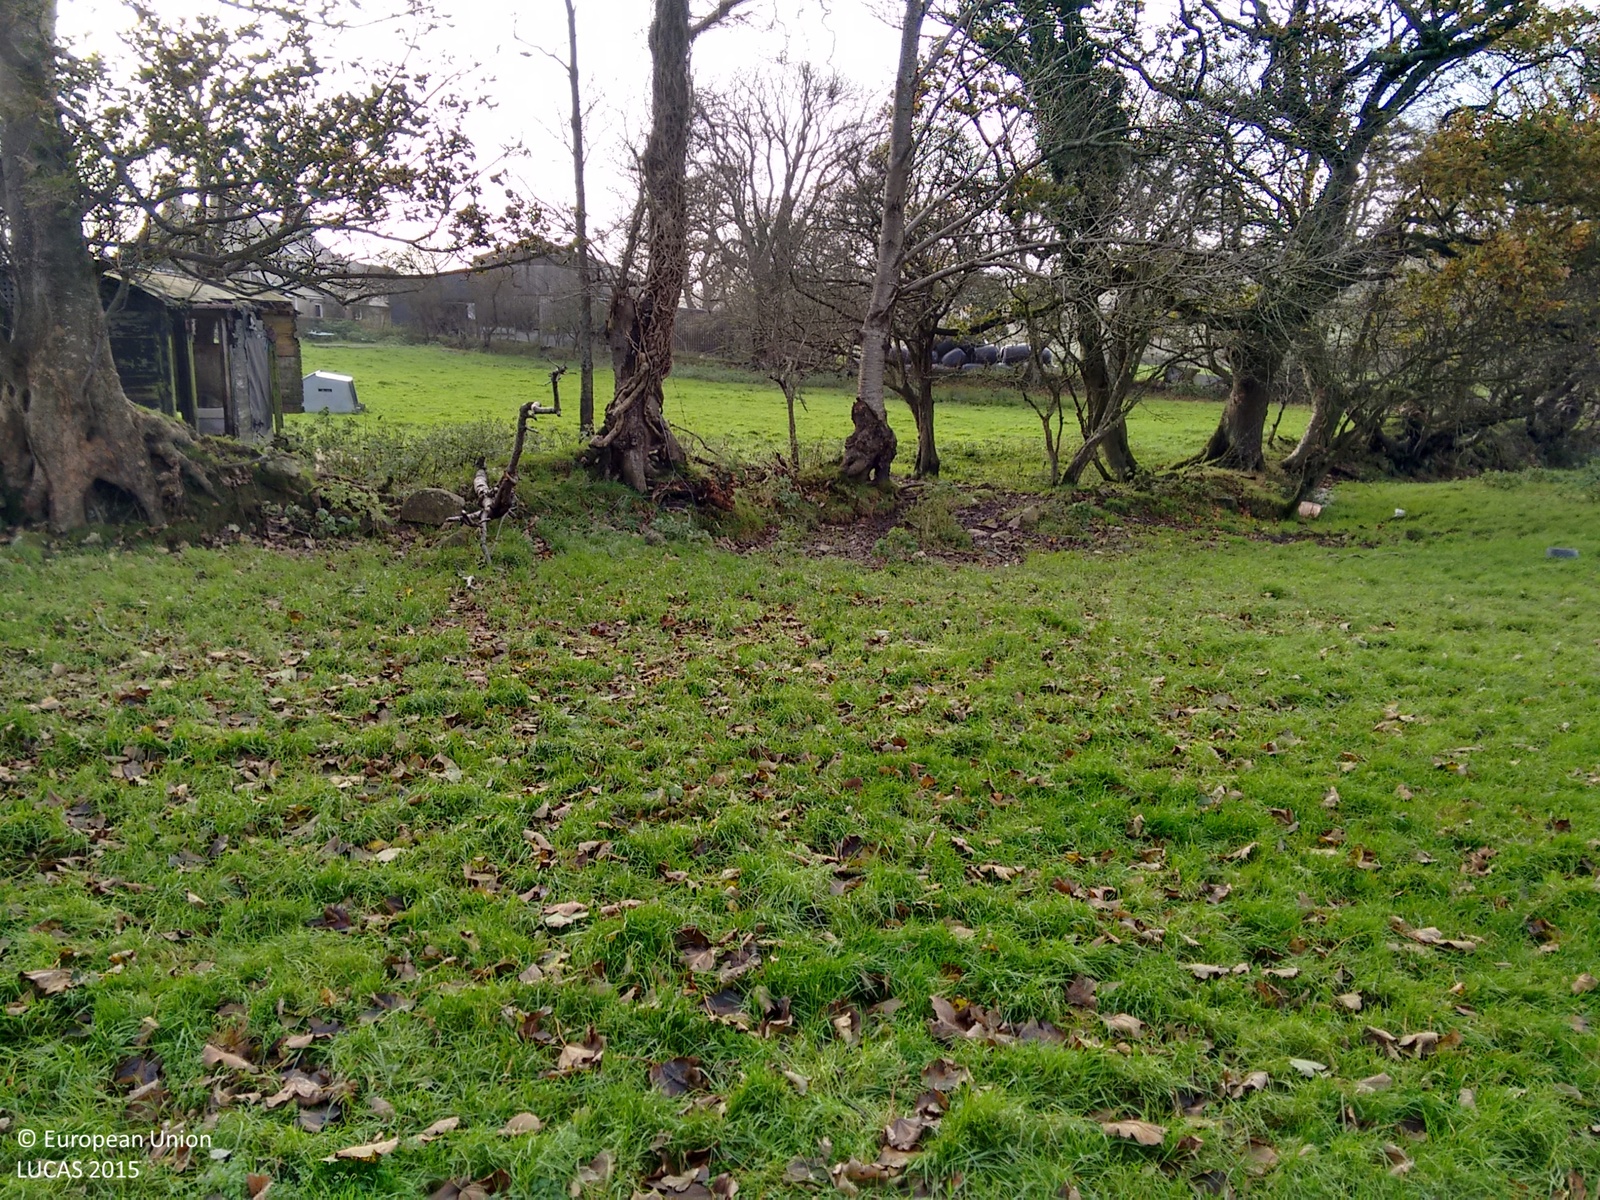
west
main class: Grassland
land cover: Grassland without tree/shrub cover
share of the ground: > 75 %
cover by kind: herbaceous plants 100 %
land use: Agriculture (excluding fallow land and kitchen gardens)
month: November
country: GB
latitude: 52.9018
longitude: -4.3898
